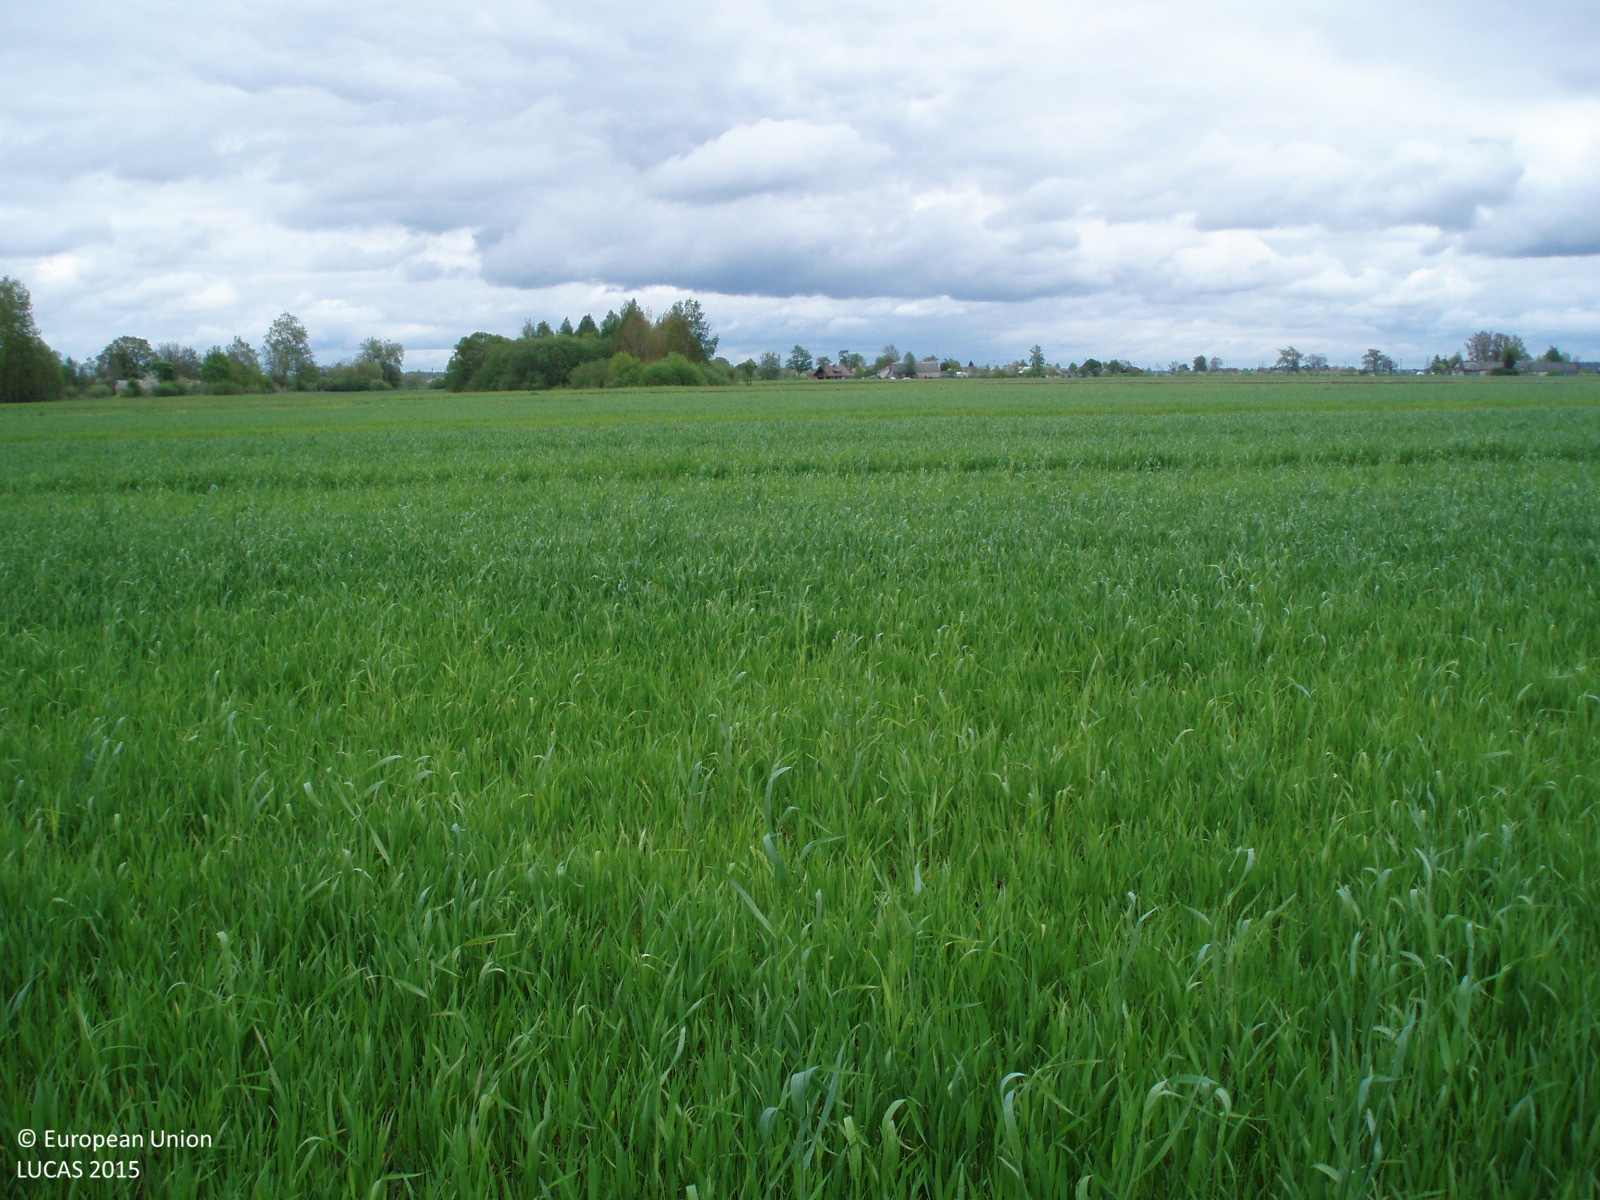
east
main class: Cropland
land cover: Rye
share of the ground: > 75 %
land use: Agriculture (excluding fallow land and kitchen gardens)
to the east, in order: Rye; Barley; Rye; Rape and turnip rape; Grassland without tree/shrub cover; Barley; Rye; Grassland without tree/shrub cover
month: May
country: LT
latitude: 56.2476
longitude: 22.5008
